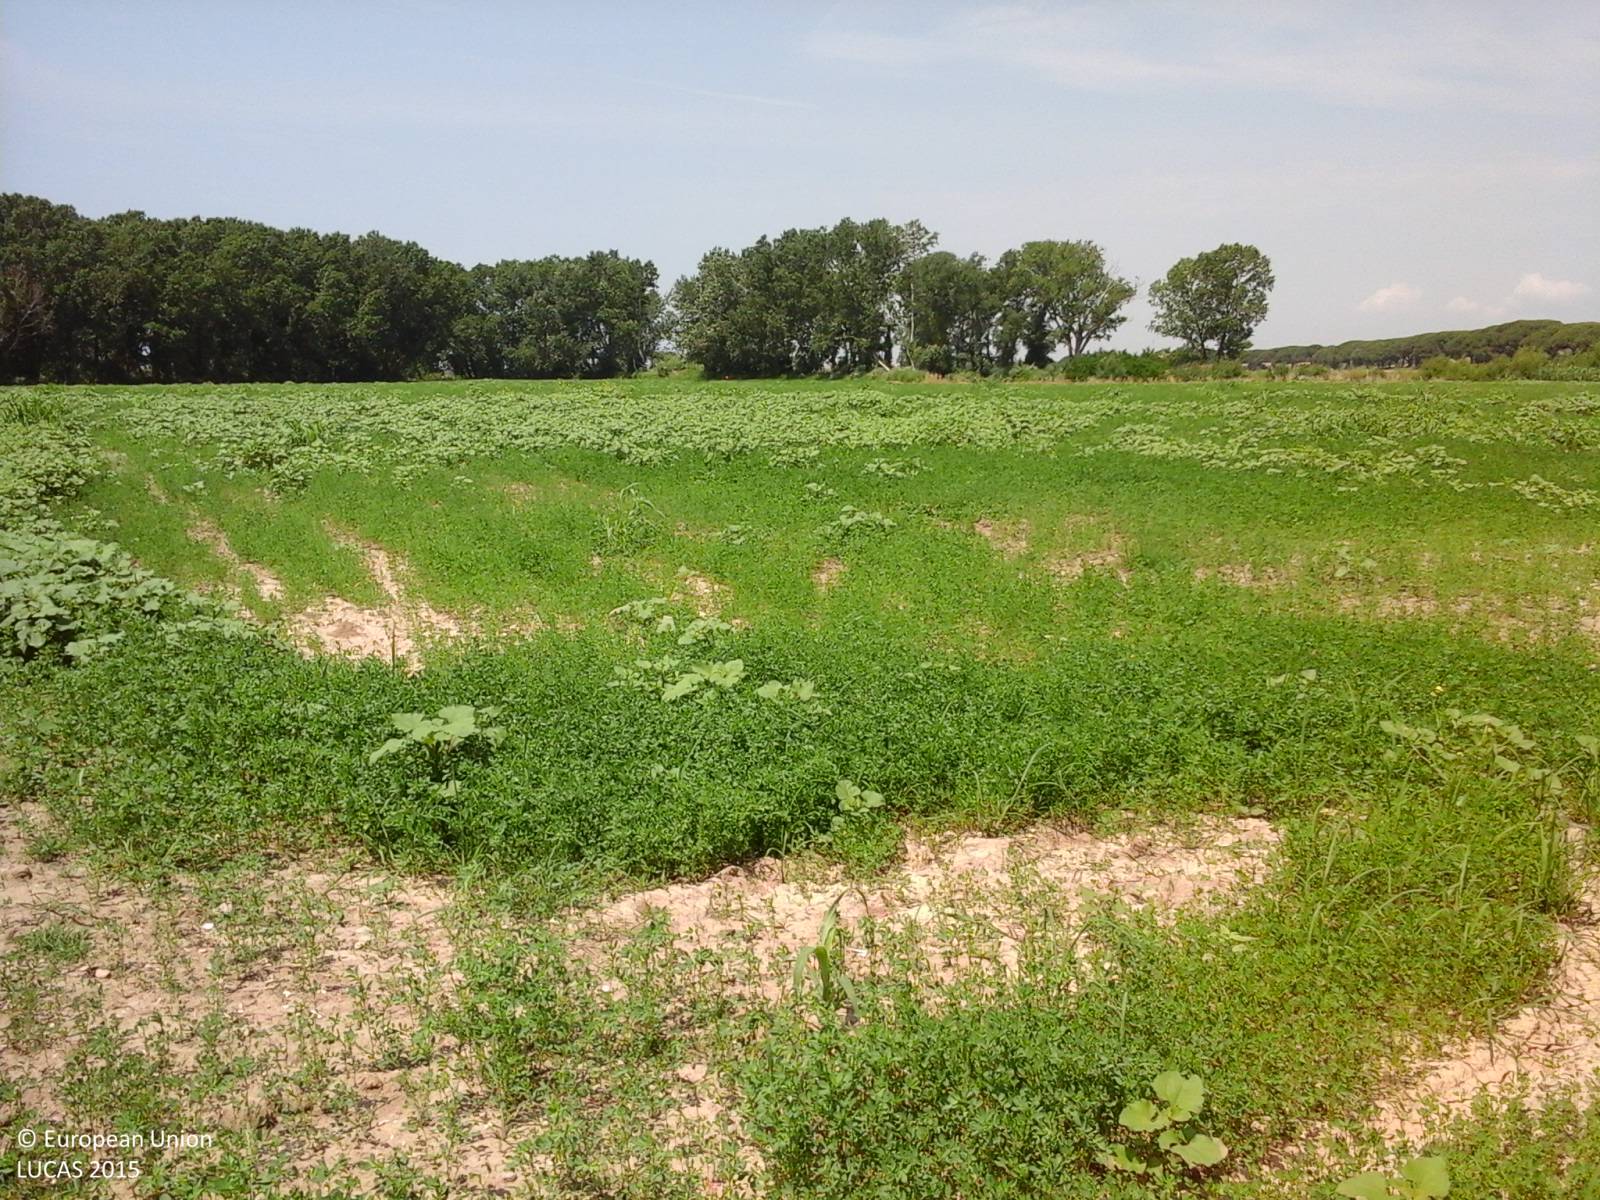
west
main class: Cropland
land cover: Lucerne
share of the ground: 50 - 75 %
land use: Agriculture (excluding fallow land and kitchen gardens)
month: June
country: IT
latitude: 42.3526
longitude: 11.5848
